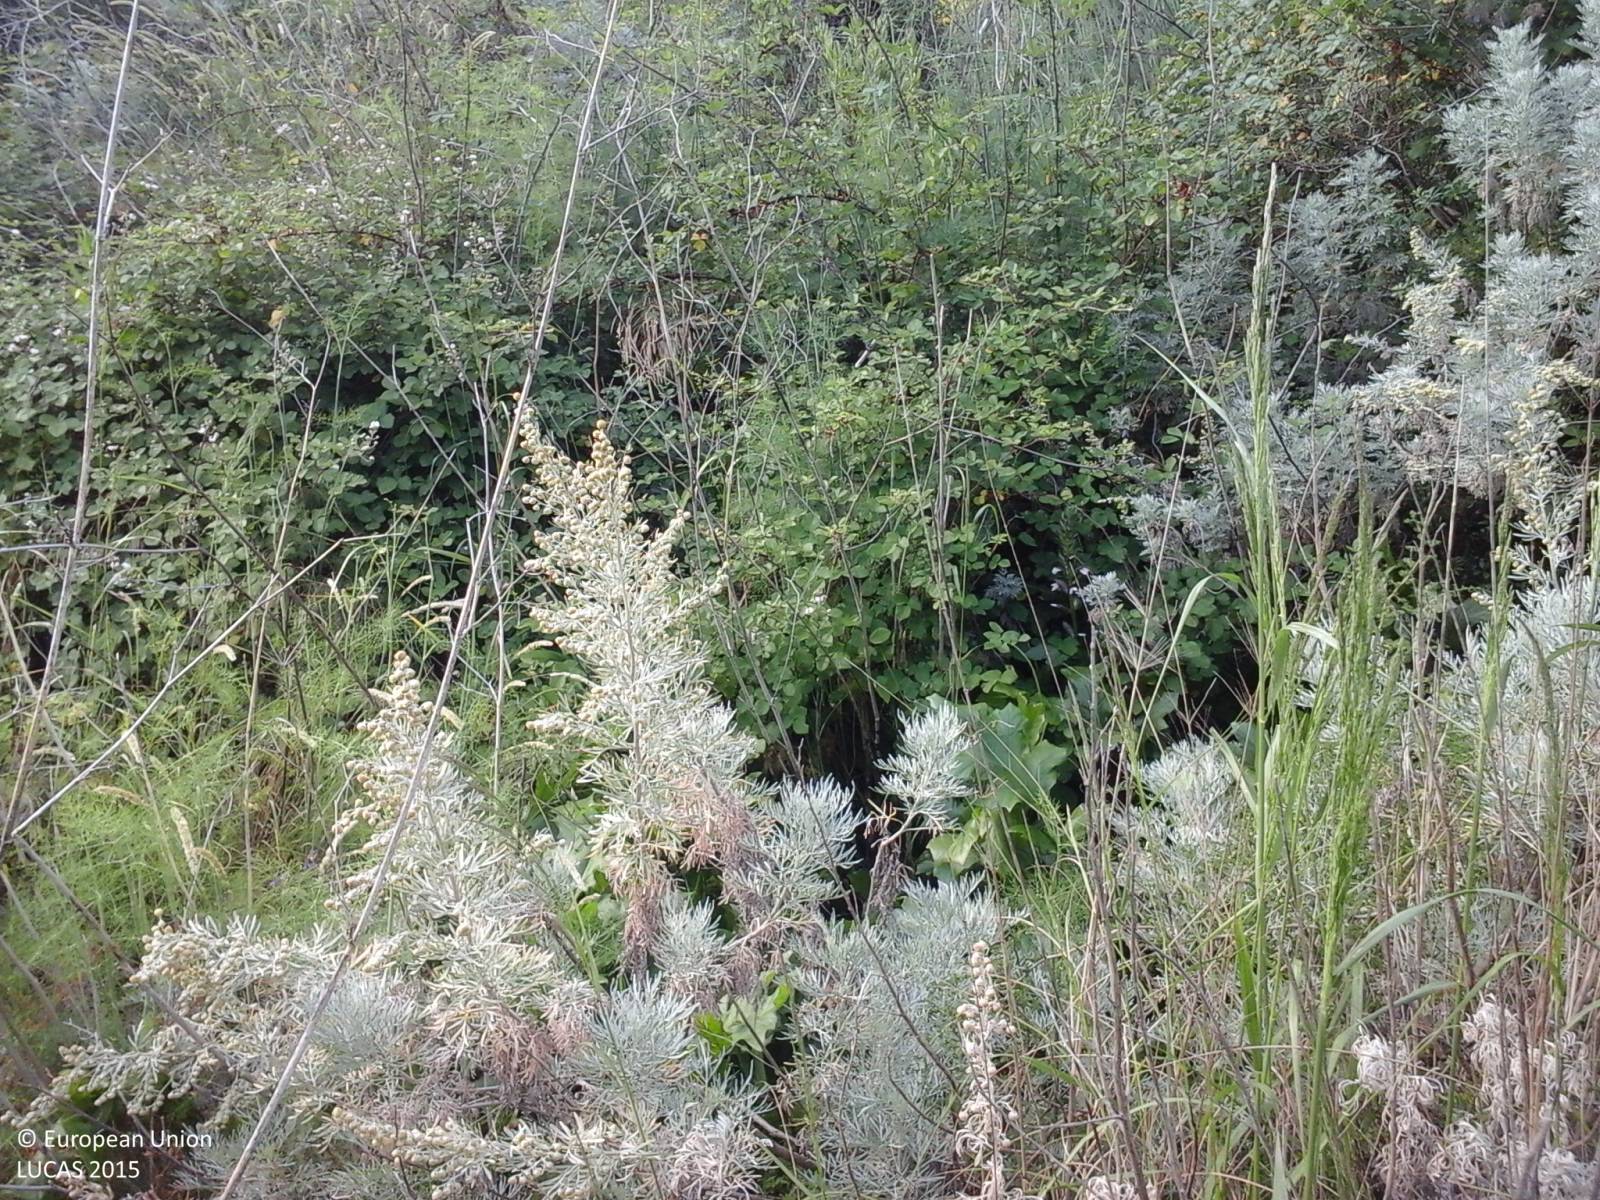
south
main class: Shrubland
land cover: Shrubland without tree cover
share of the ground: > 75 %
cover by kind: shrubs 85 %, herbaceous plants 15 %
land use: Semi-natural and natural areas not in use
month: June
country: IT
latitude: 40.6914
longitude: 8.5751
